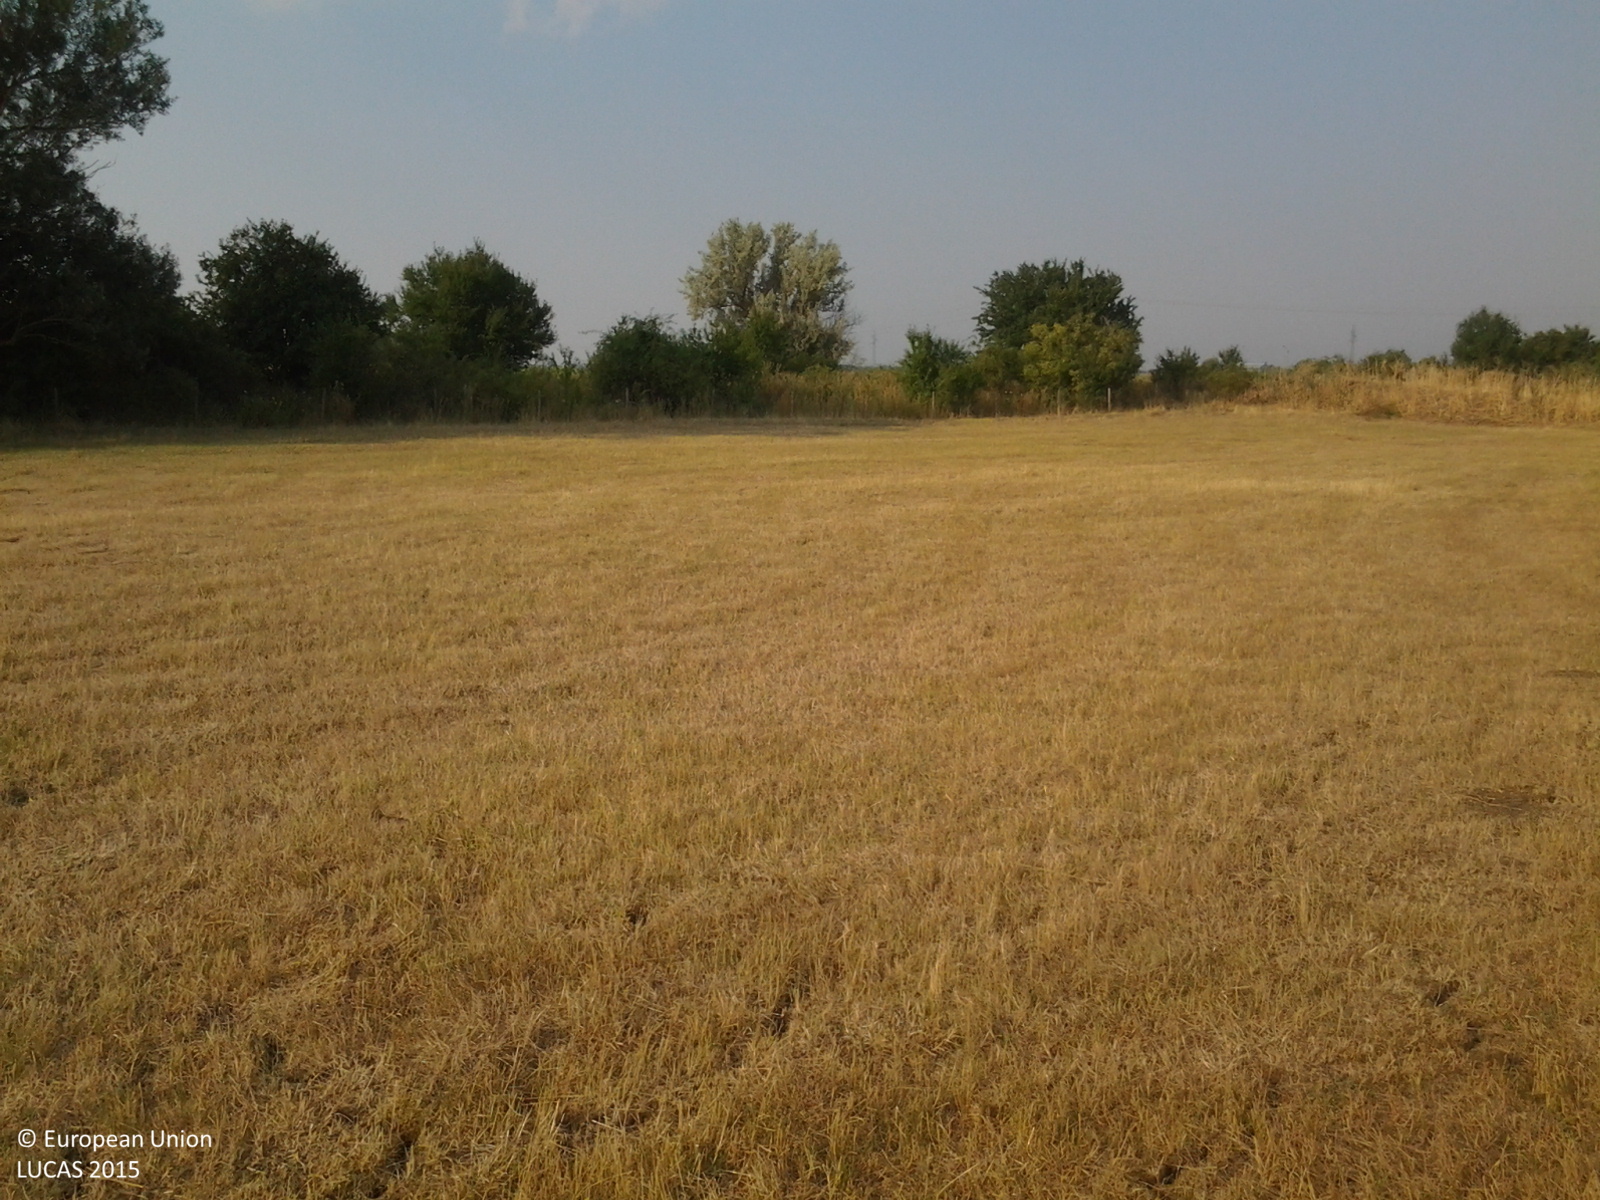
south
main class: Grassland
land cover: Grassland without tree/shrub cover
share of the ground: > 75 %
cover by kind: herbaceous plants 100 %
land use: Agriculture (excluding fallow land and kitchen gardens)
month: July
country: HU
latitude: 46.9785
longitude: 20.6655
